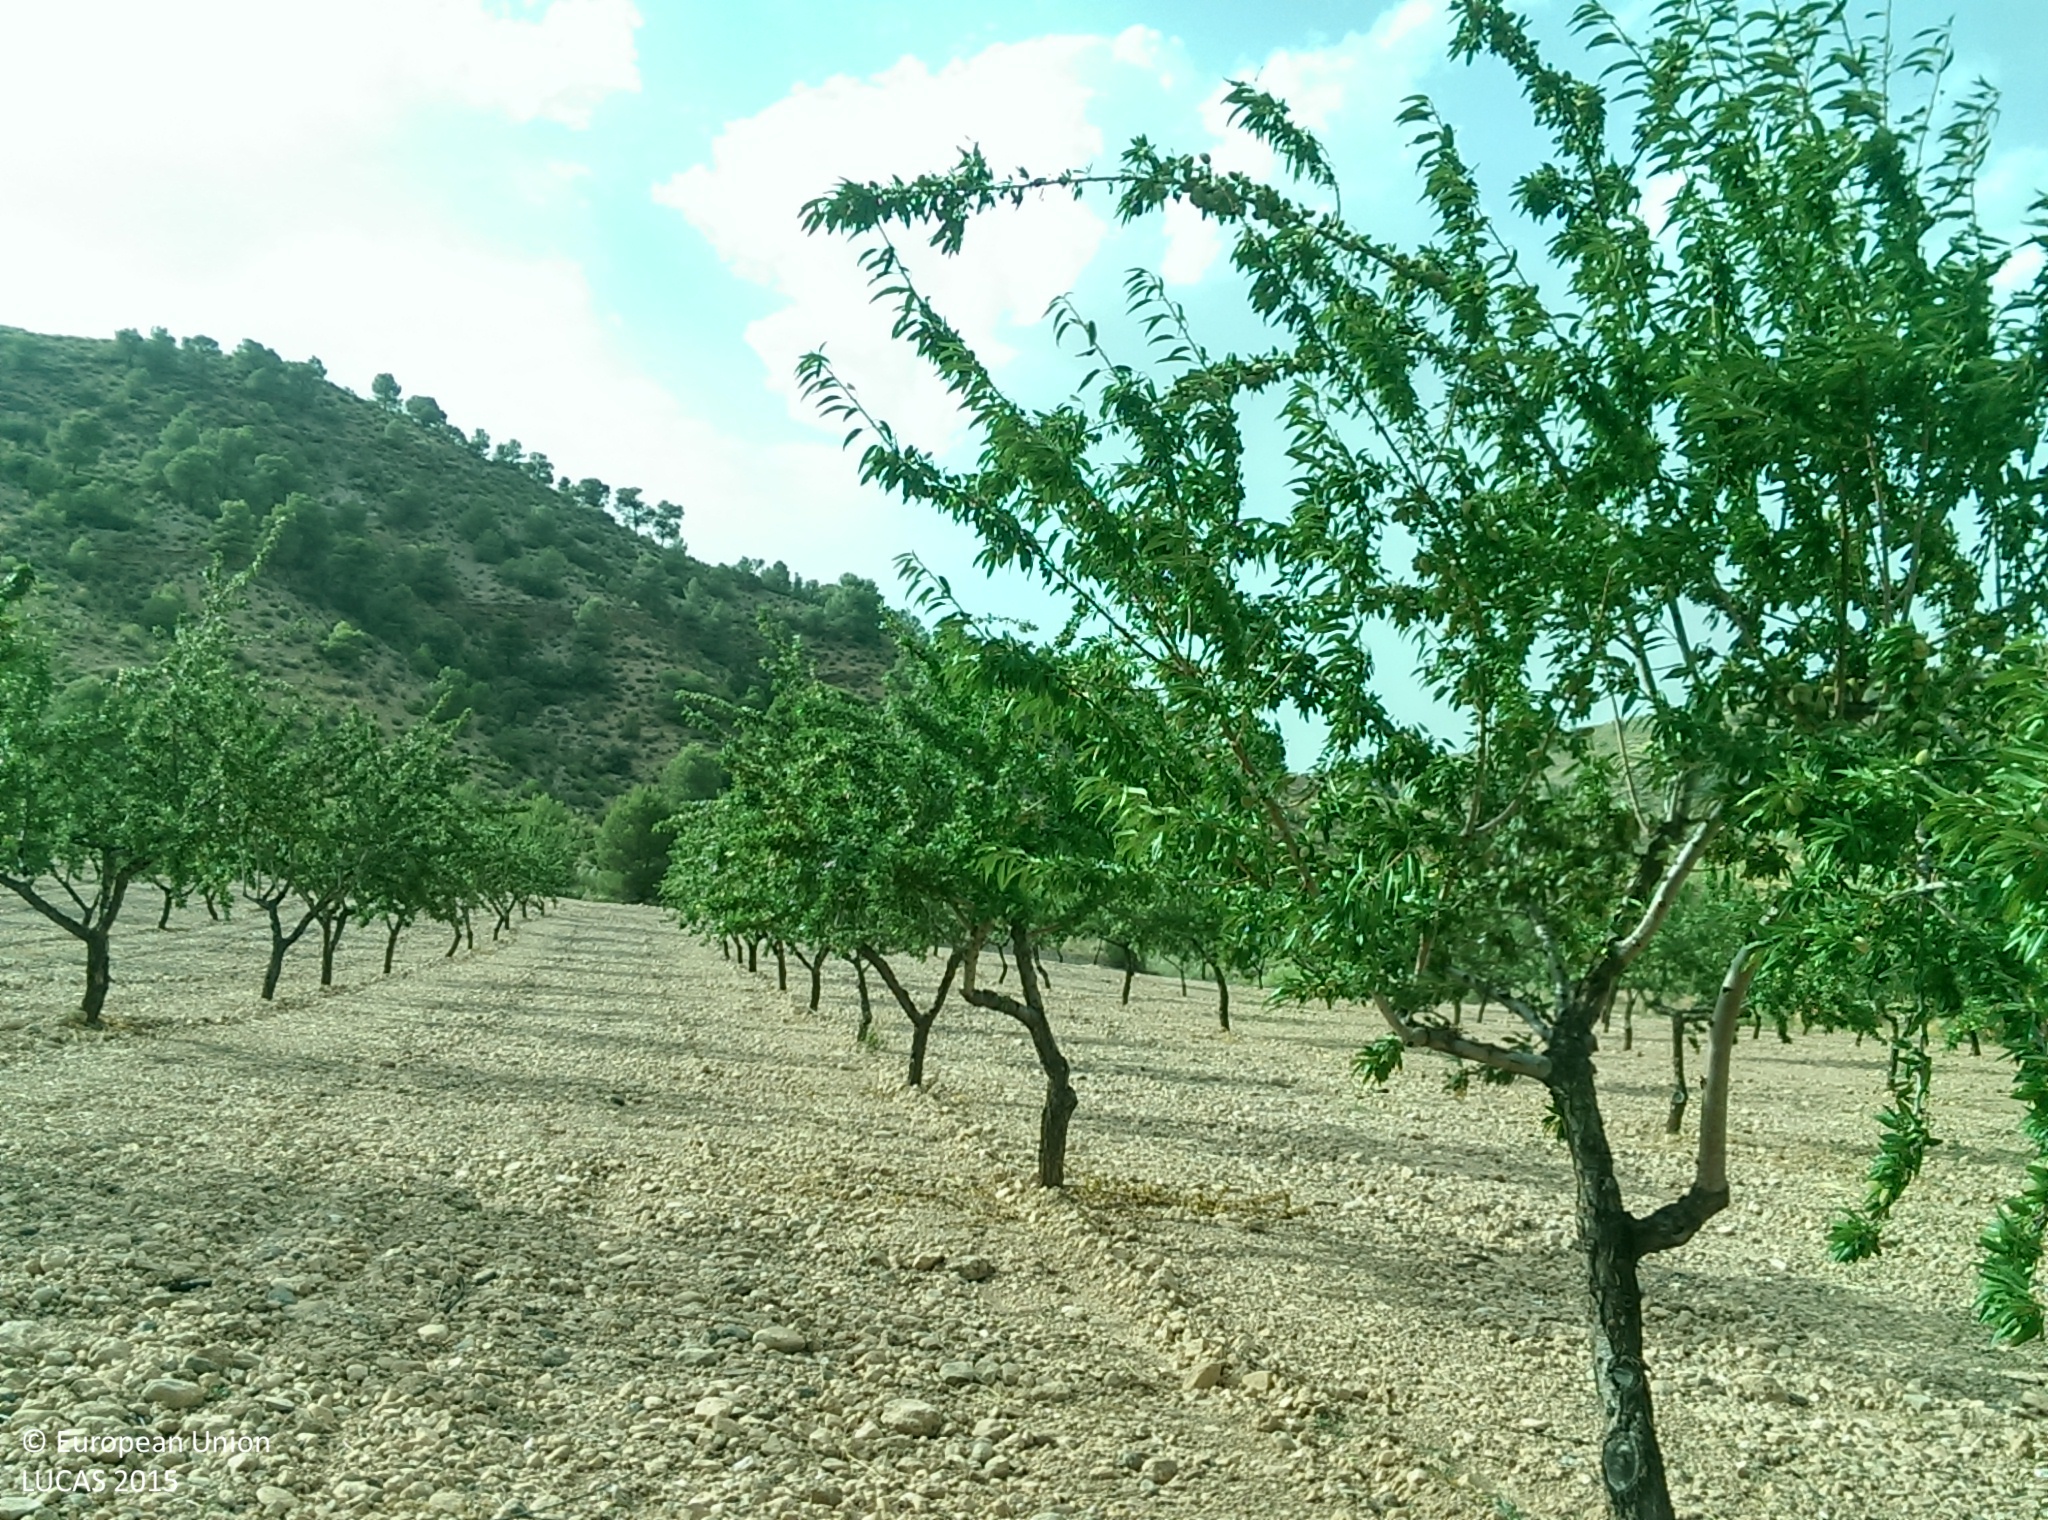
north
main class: Cropland
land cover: Nuts trees
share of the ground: 25 - 50 %
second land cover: Other bare soil
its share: > 75 %
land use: Agriculture (excluding fallow land and kitchen gardens)
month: July
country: ES
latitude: 37.4895
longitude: -2.8926
